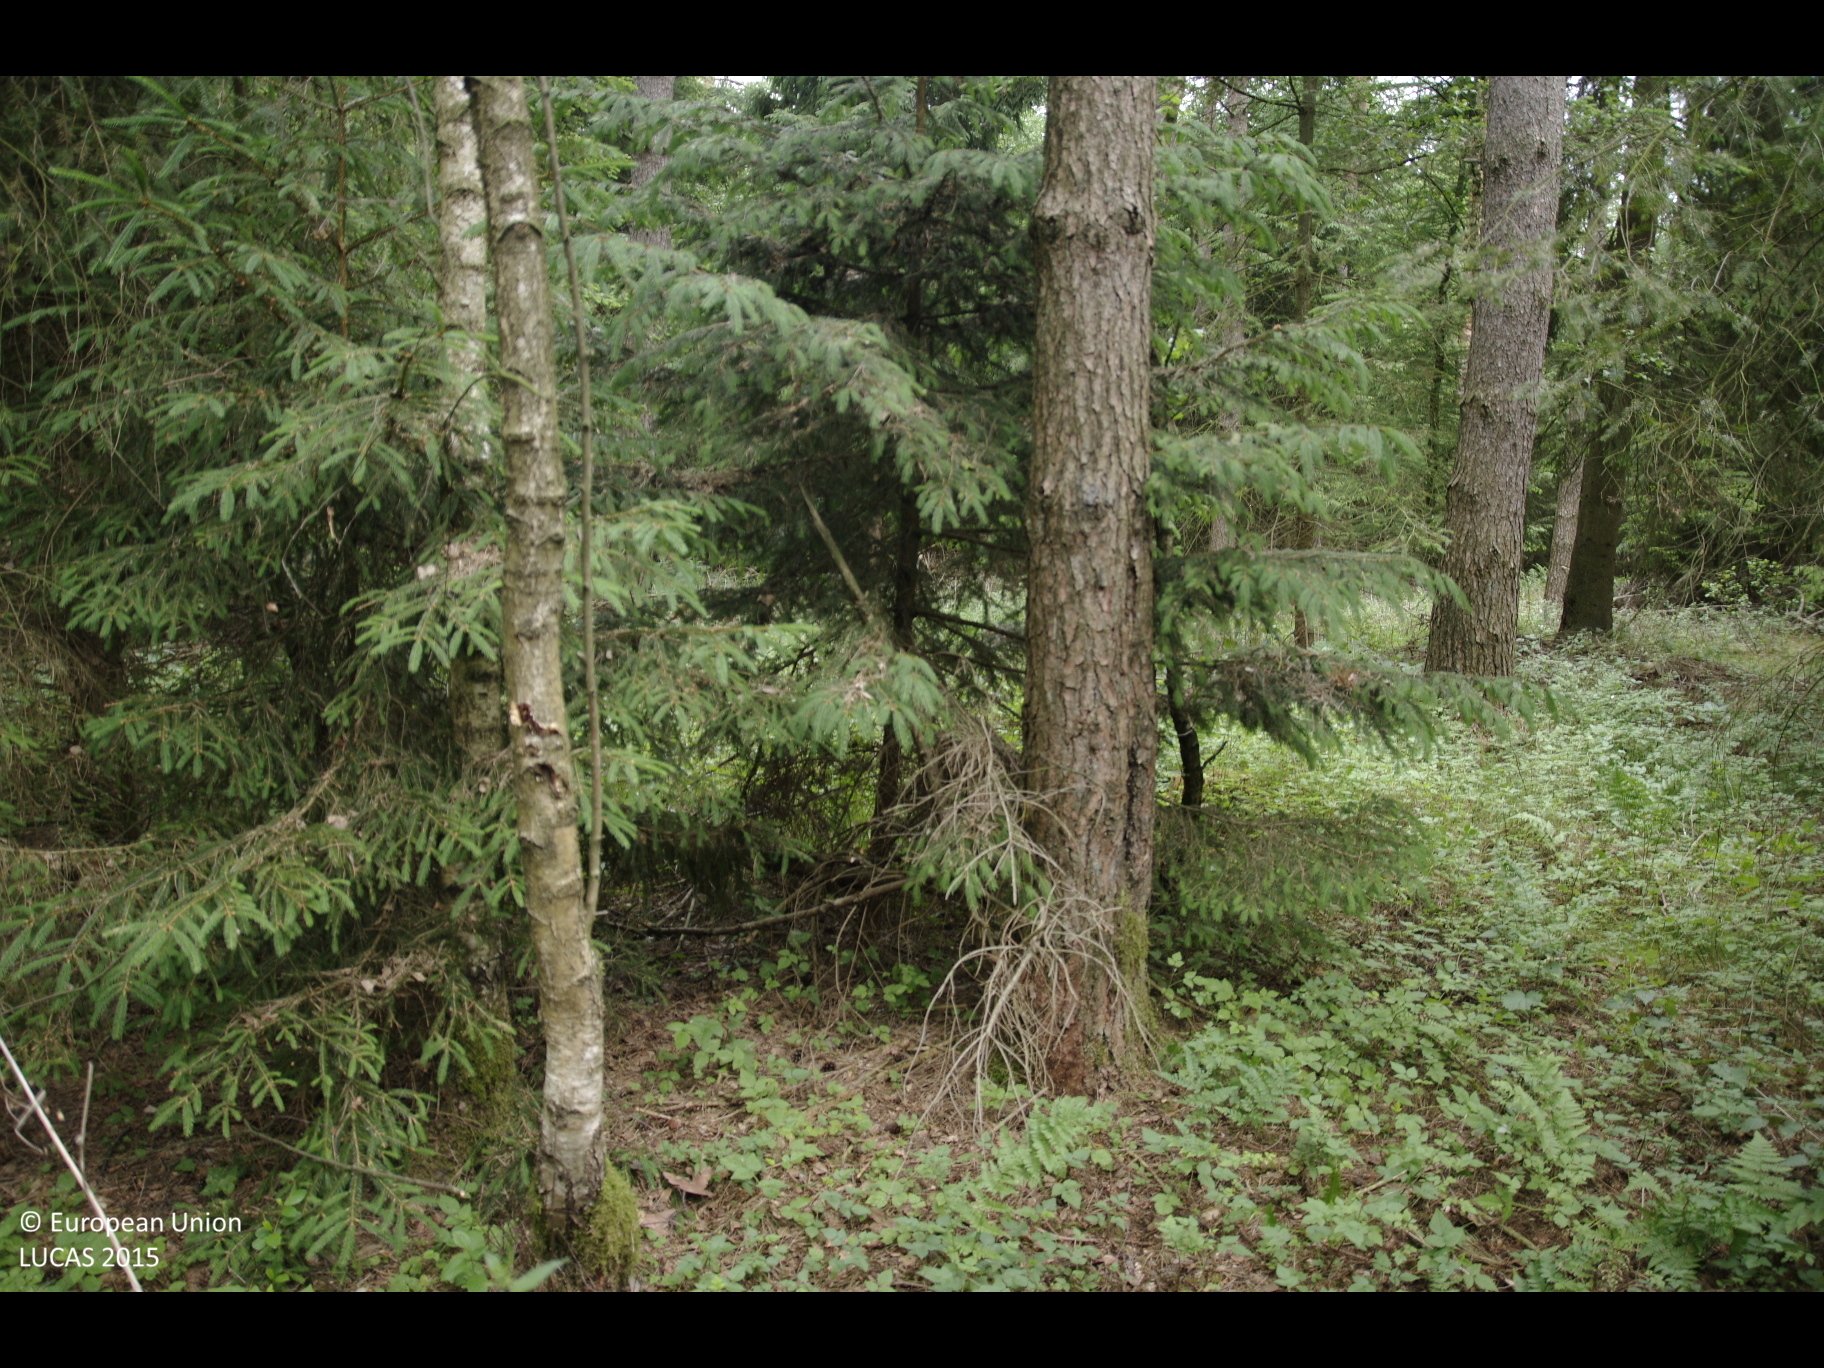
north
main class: Woodland
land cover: Other coniferous woodland
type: hemiboreal forest and nemoral coniferous forest and mixed broadleaved-coniferous forest
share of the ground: 50 - 75 %
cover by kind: coniferous forest trees 60 %, shrubs 10 %, herbaceous plants 10 %, unconsolidated bare surface 10 %, broadleaved forest trees 5 %, lichens and mosses 5 %
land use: Forestry
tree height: > 5 m
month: June
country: DE
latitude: 53.1679
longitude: 10.3140
